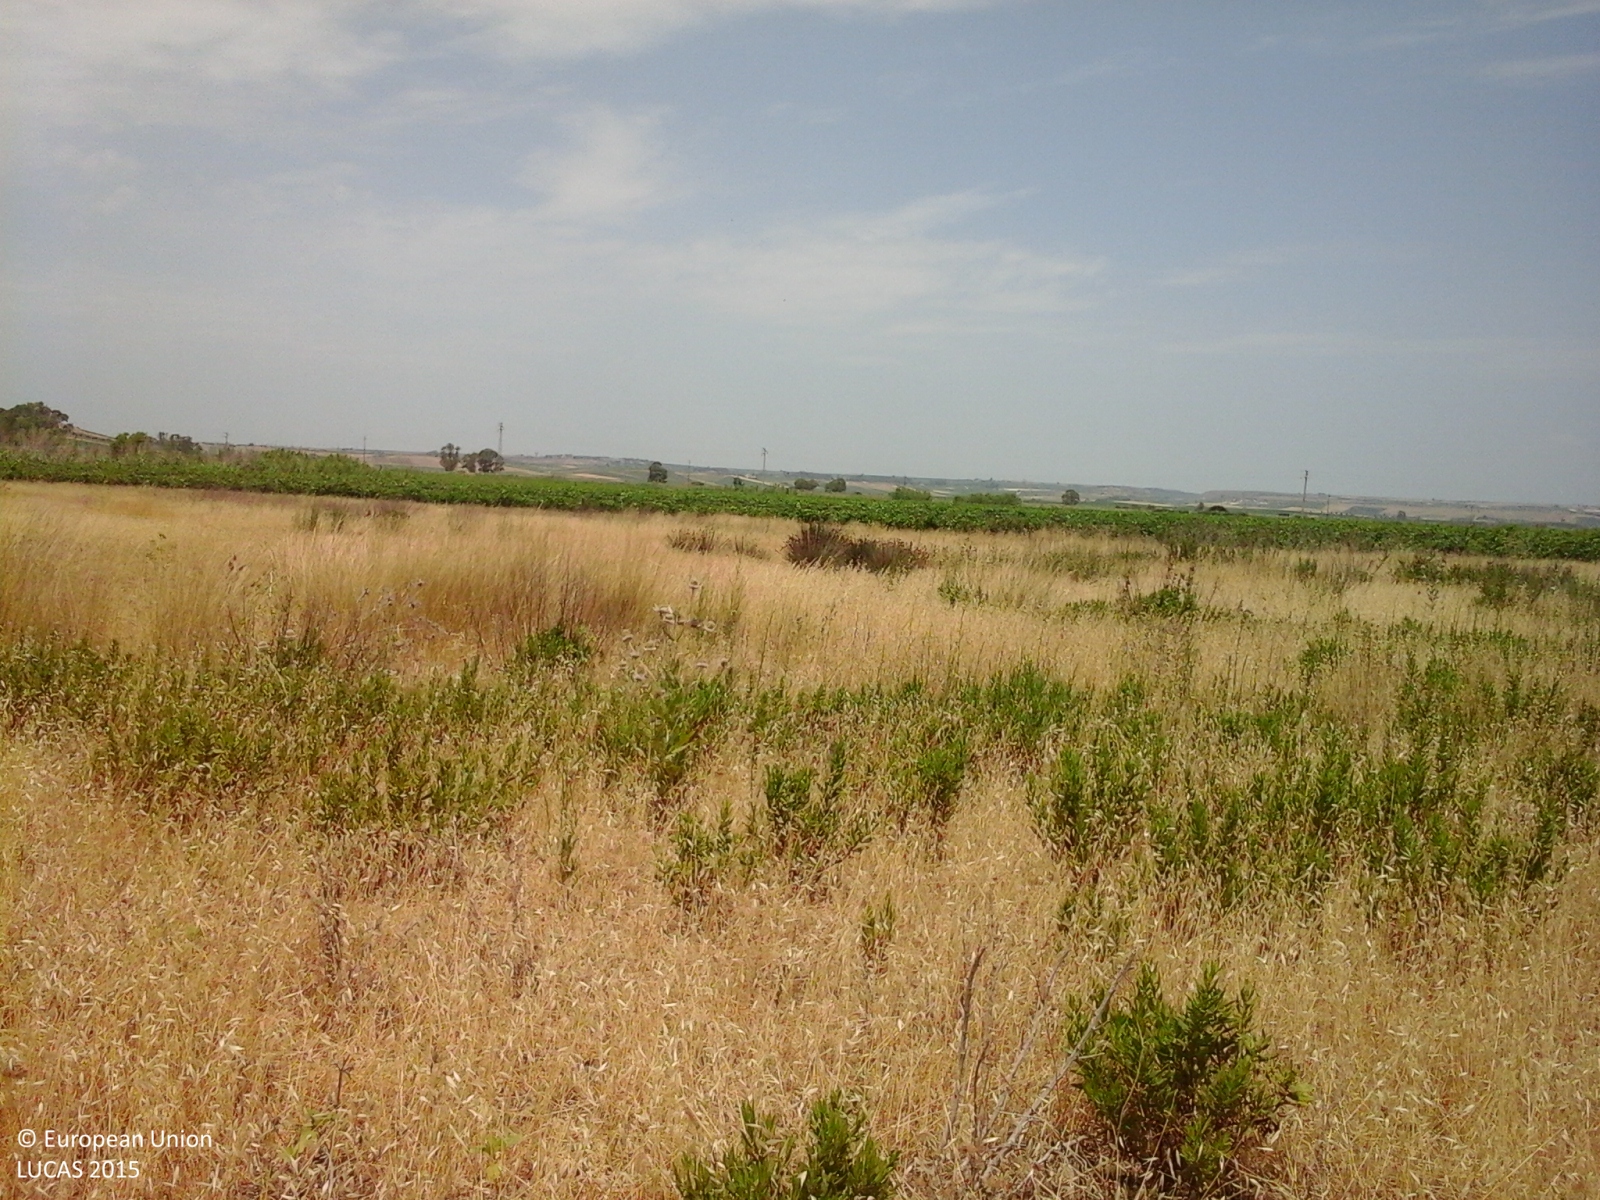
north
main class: Grassland
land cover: Spontaneously vegetated surfaces
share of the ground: > 75 %
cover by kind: herbaceous plants 100 %
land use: Fallow land
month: May
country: IT
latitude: 37.6557
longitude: 12.6661
